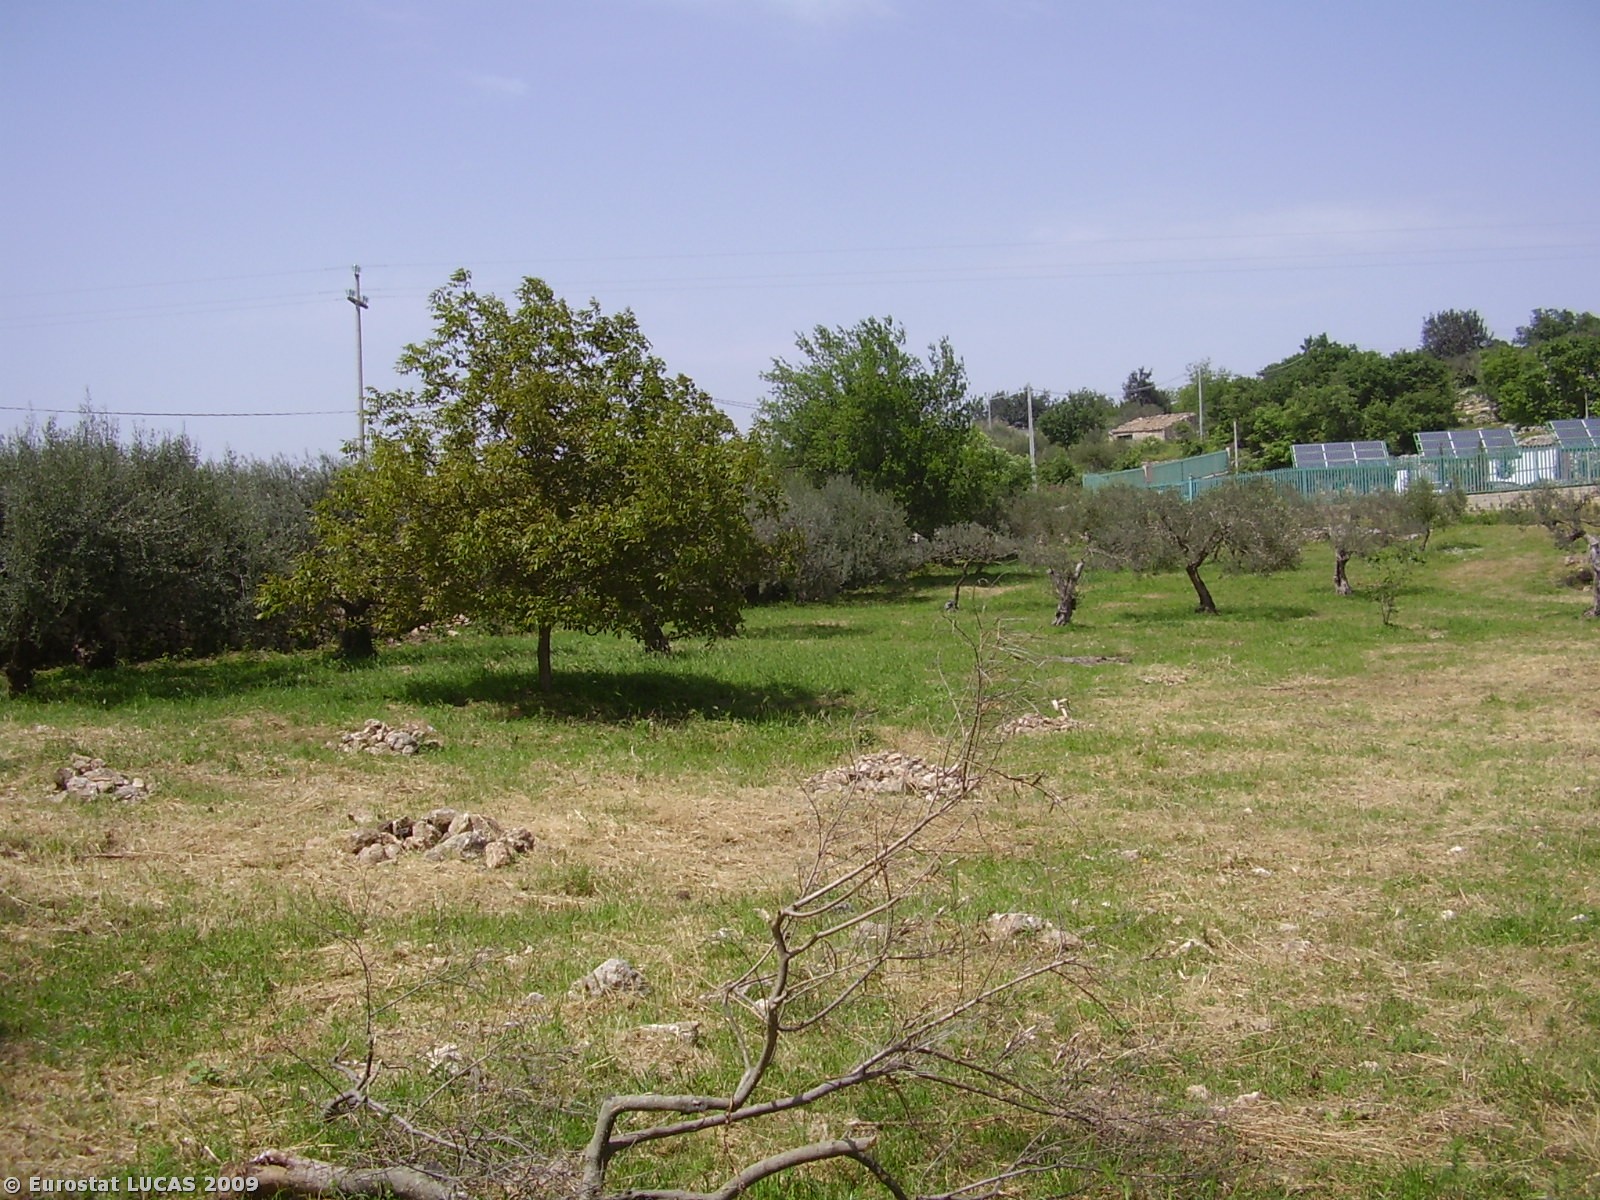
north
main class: Shrubland
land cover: Shrubland with sparse tree cover
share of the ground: 50 - 75 %
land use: Agriculture (excluding fallow land and kitchen gardens)
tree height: < 5 m
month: May
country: IT
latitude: 37.1276
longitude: 14.9485
